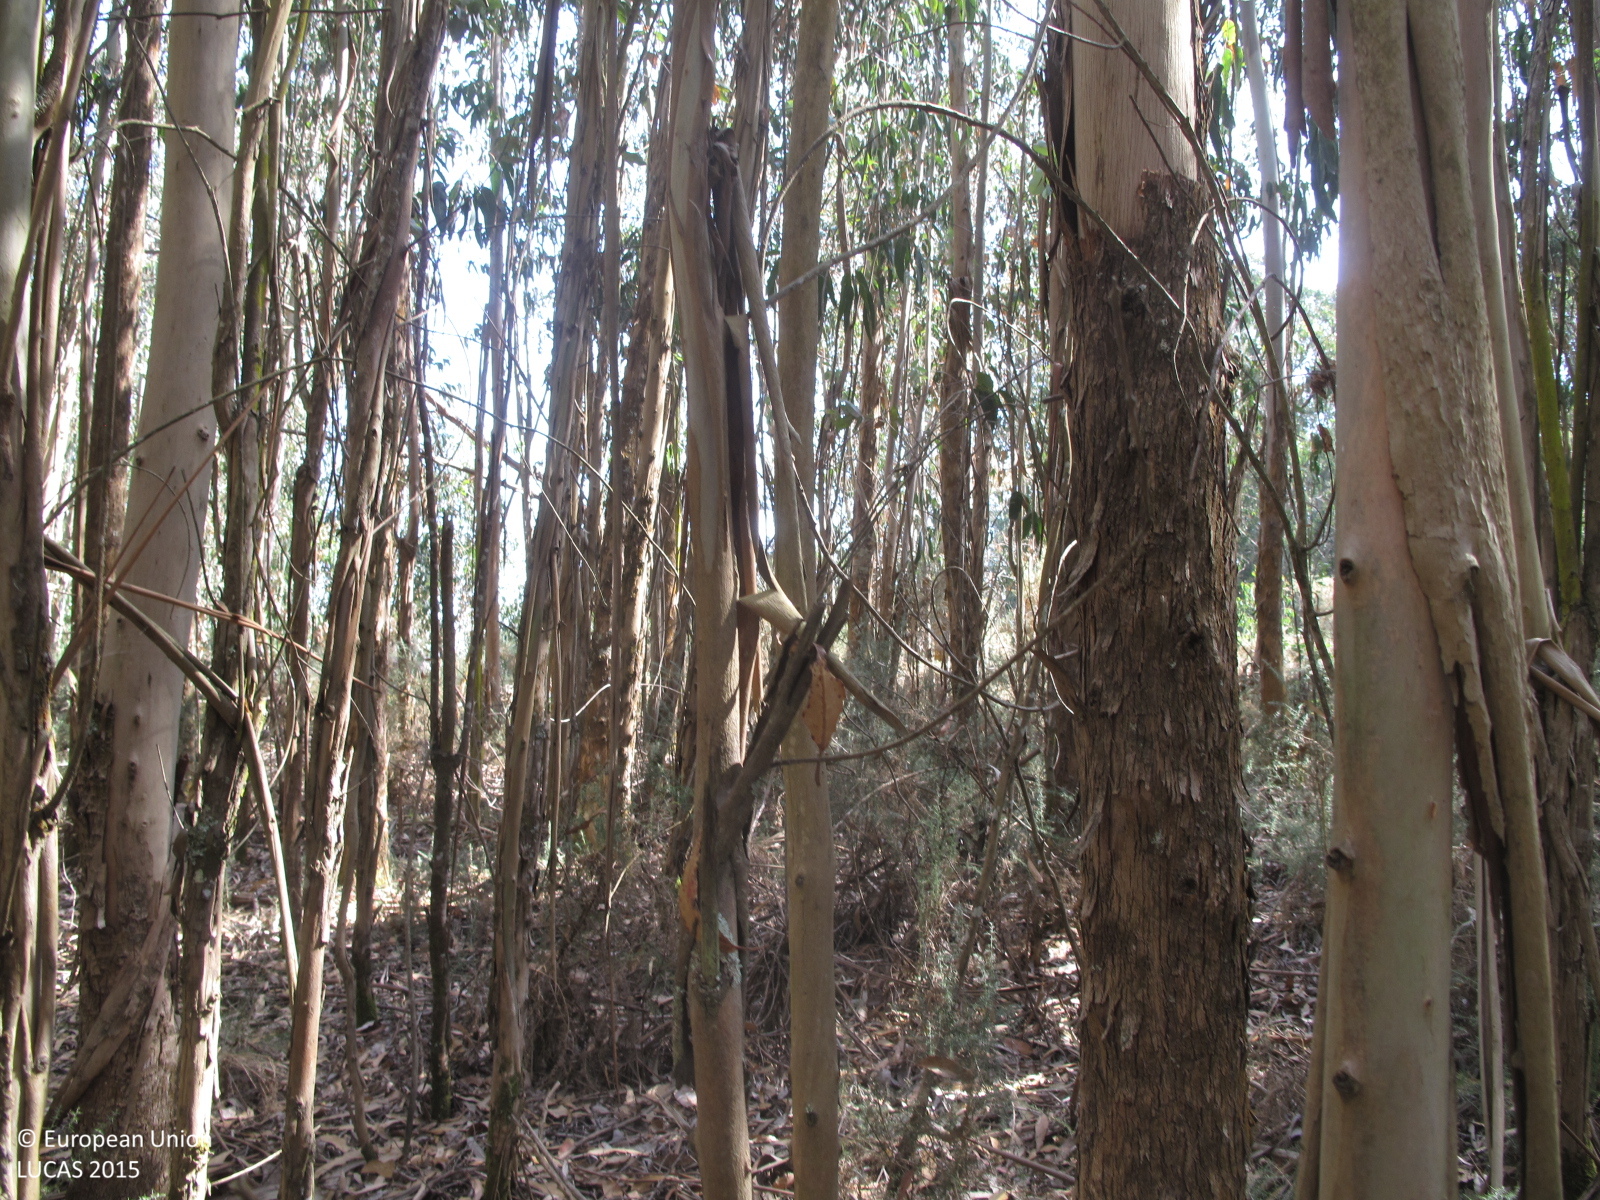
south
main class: Woodland
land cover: Broadleaved woodland
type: exotic forest
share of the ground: > 75 %
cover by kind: broadleaved forest trees 90 %, shrubs 5 %, unconsolidated bare surface 5 %
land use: Forestry
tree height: > 5 m
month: July
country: ES
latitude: 43.4435
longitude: -8.3050
